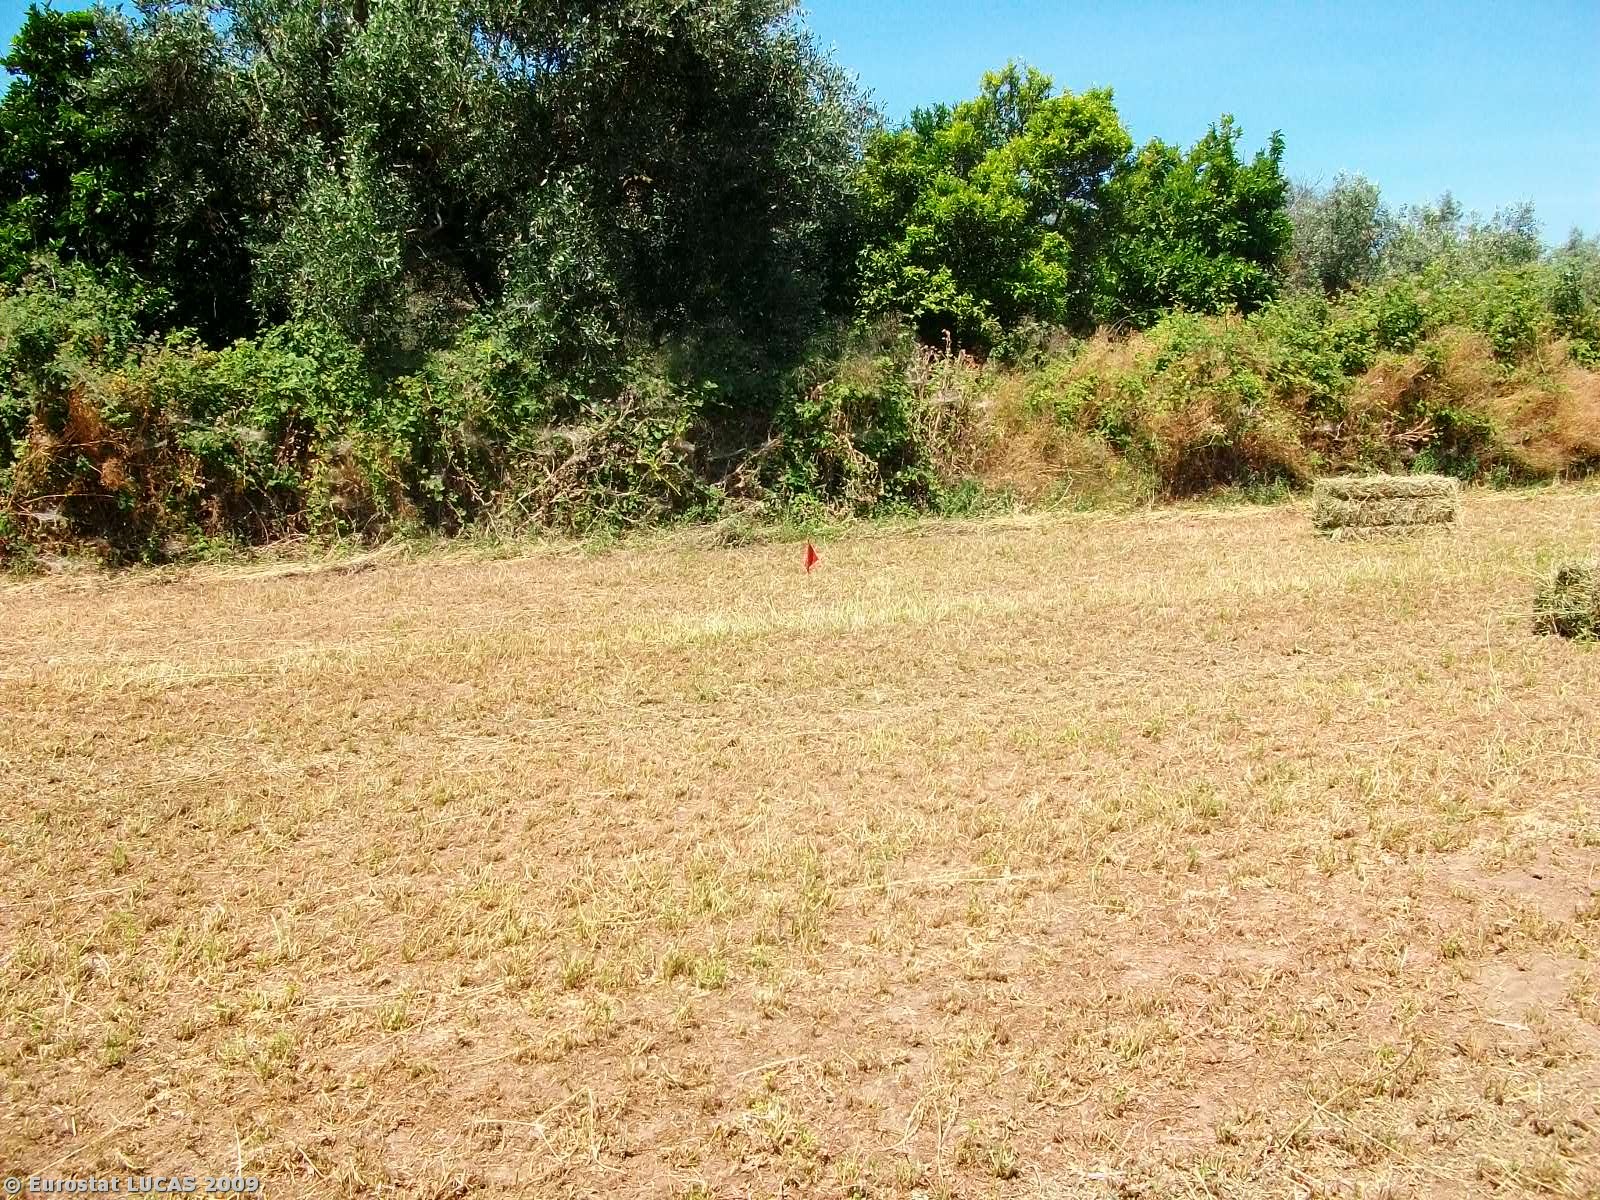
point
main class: Cropland
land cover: Lucerne
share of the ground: > 75 %
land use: Agriculture (excluding fallow land and kitchen gardens)
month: June
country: GR
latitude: 38.5733
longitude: 21.4361
